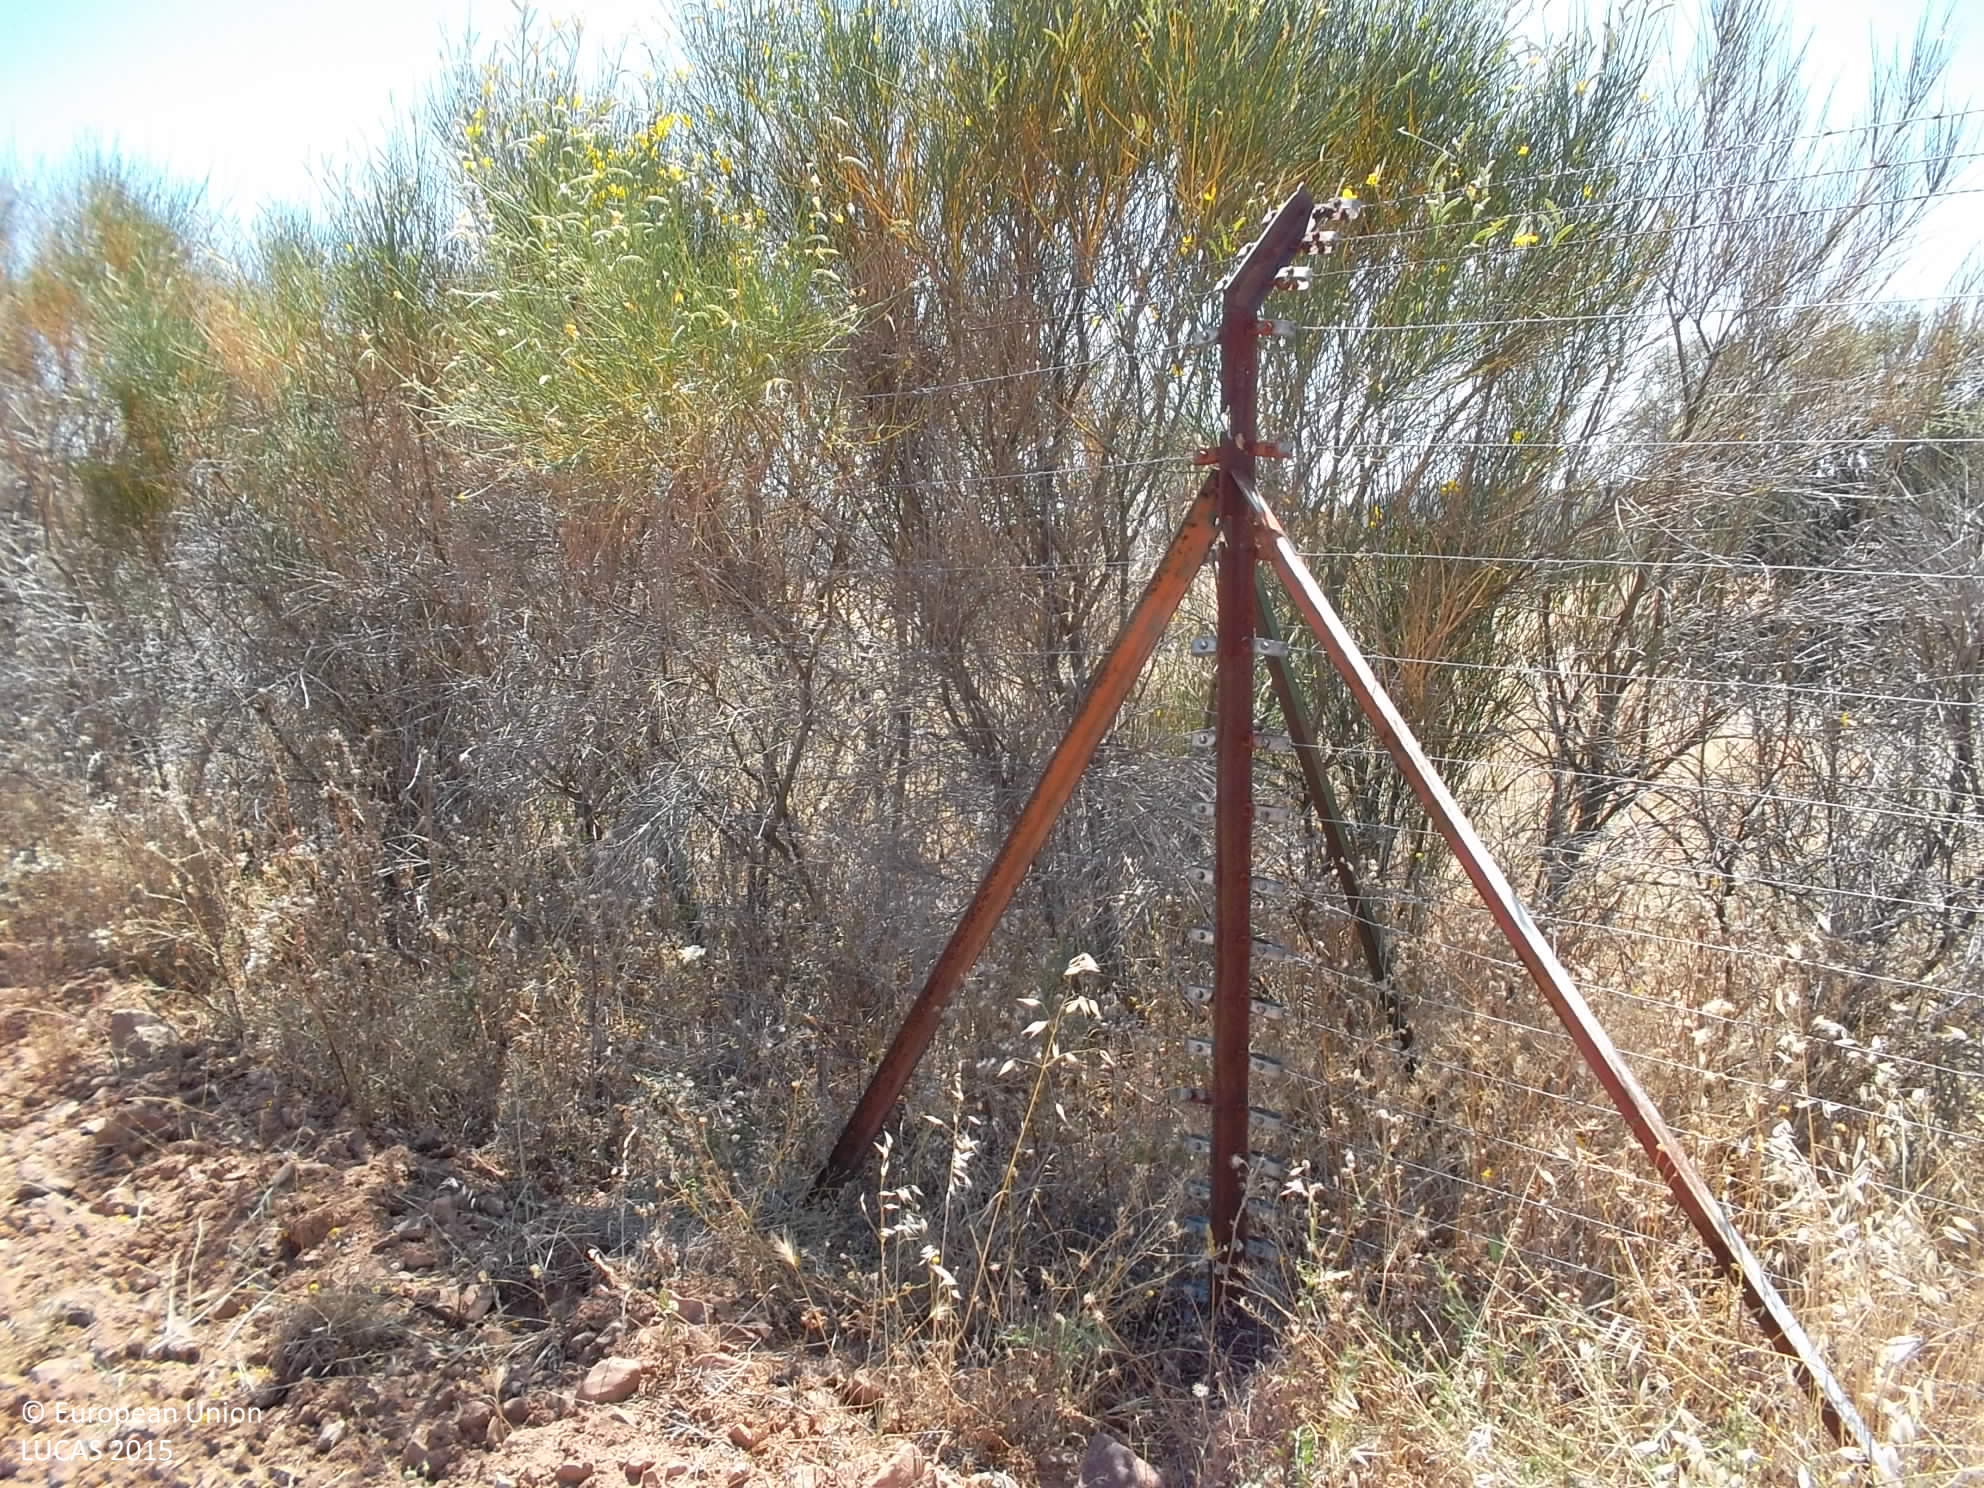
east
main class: Woodland
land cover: Broadleaved woodland
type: broadleaved evergreen forest
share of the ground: 10 - 25 %
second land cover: Spontaneously vegetated surfaces
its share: > 75 %
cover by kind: herbaceous plants 60 %, broadleaved forest trees 20 %, shrubs 20 %
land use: Forestry
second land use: Agriculture (excluding fallow land and kitchen gardens)
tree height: > 5 m
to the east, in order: Broadleaved woodland; Spontaneously vegetated surfaces; Grassland without tree/shrub cover; Single bushes/trees; Grassland without tree/shrub cover; Tracks; Grassland without tree/shrub cover
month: June
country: ES
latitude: 39.1250
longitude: -4.0316
